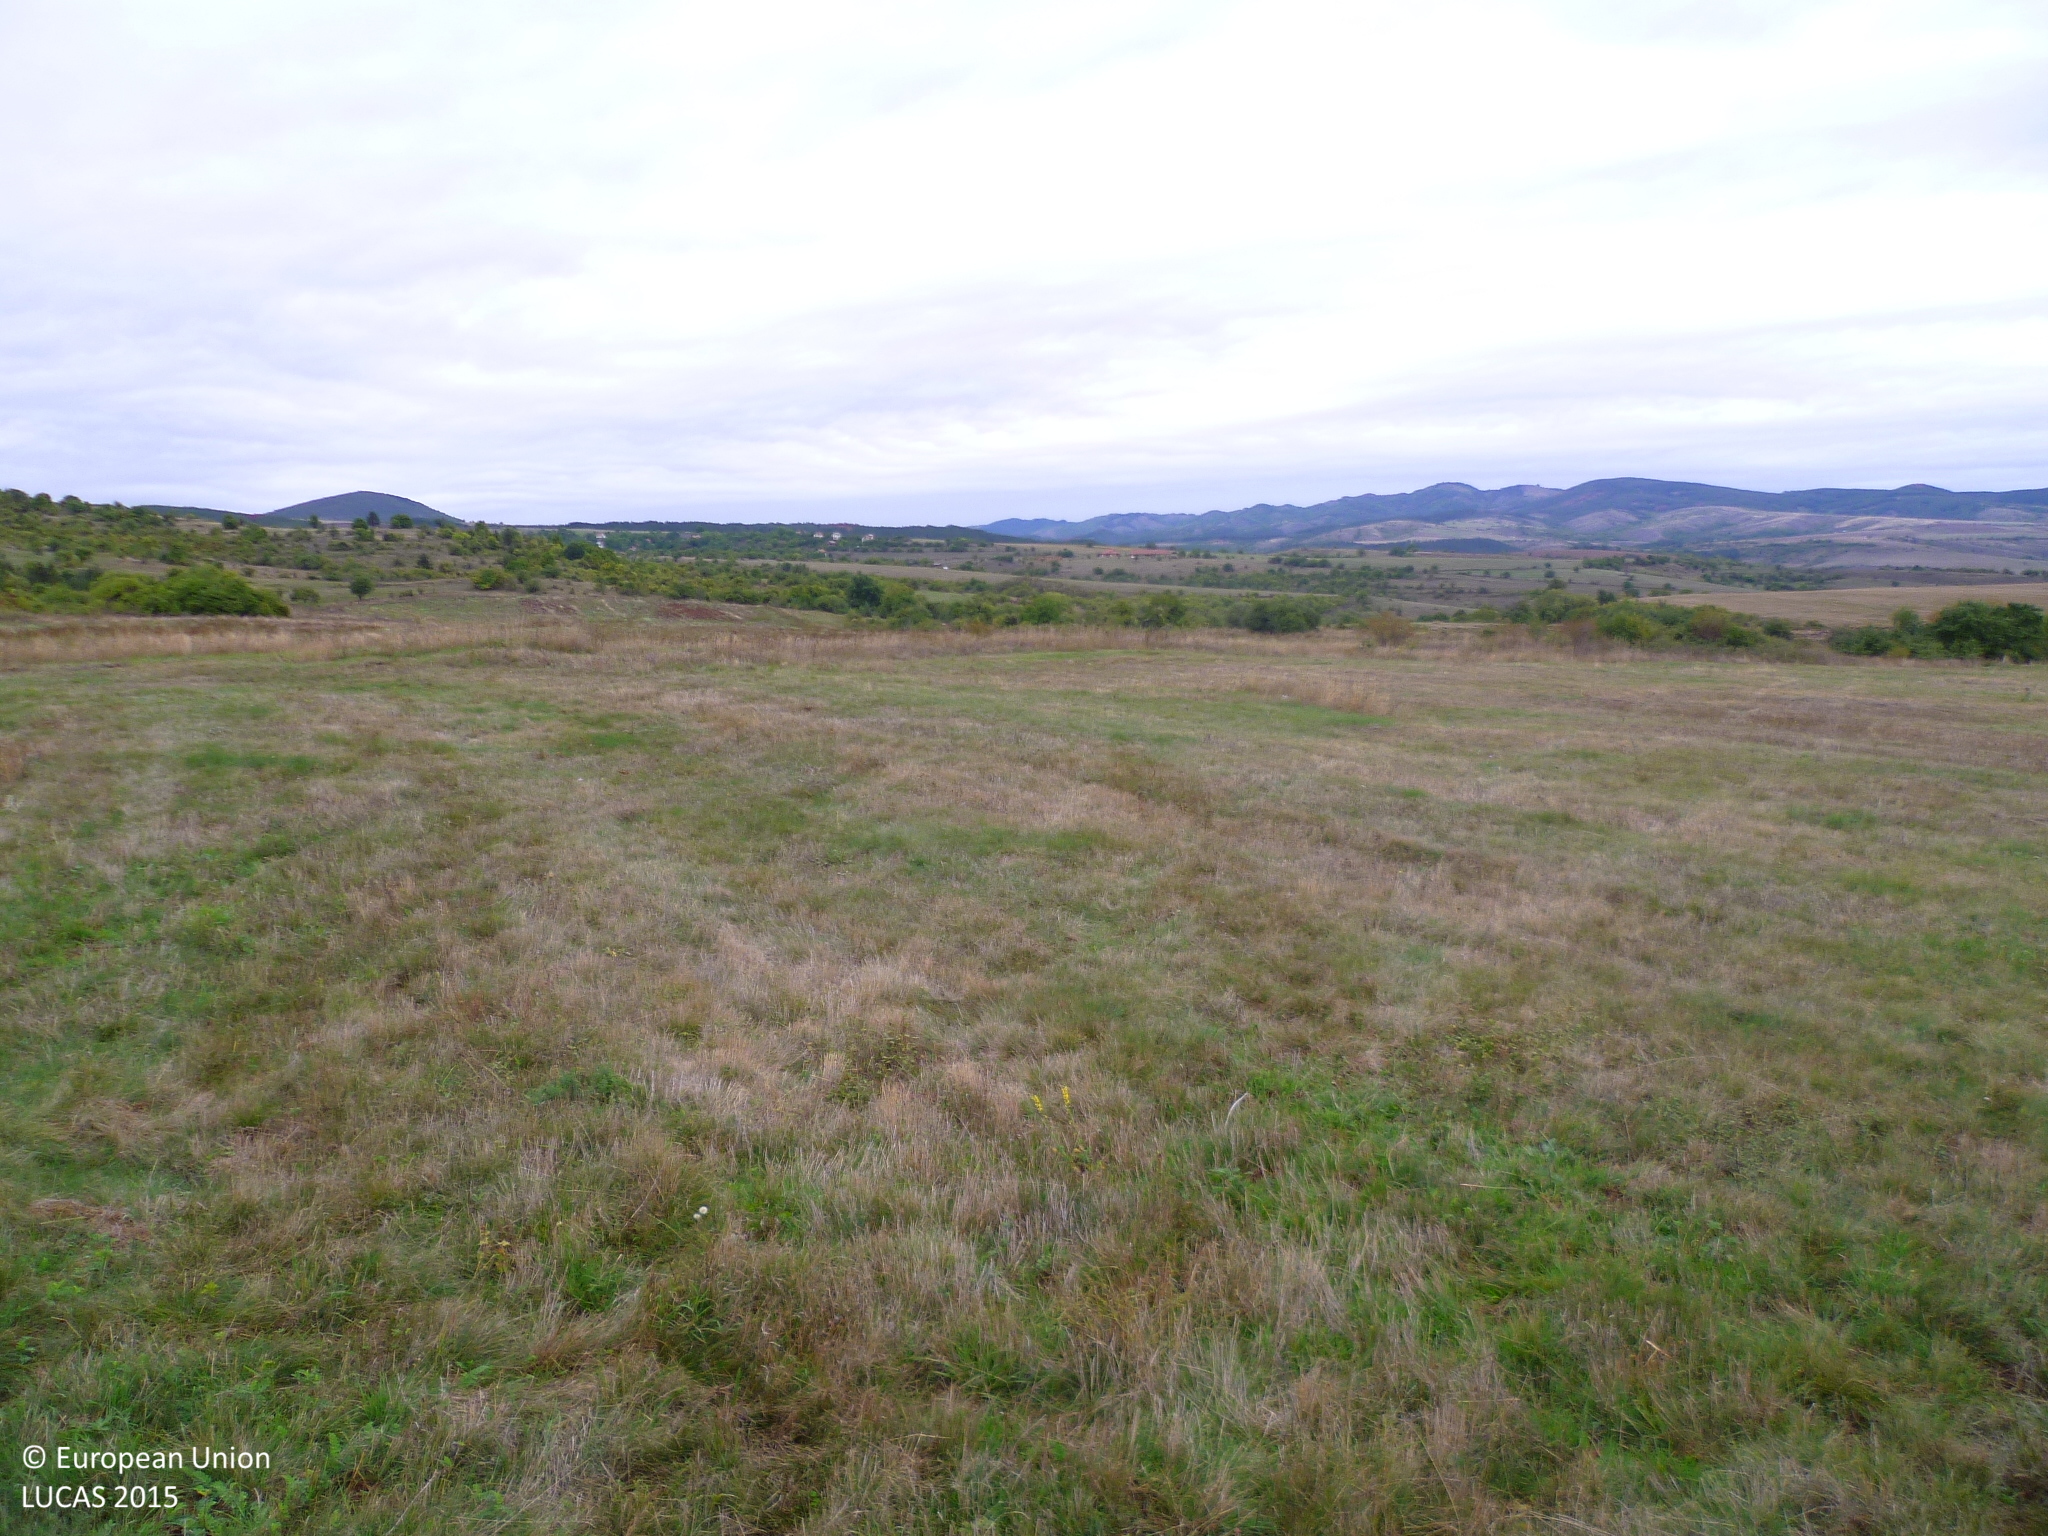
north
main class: Grassland
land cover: Grassland without tree/shrub cover
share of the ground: > 75 %
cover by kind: herbaceous plants 100 %
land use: Agriculture (excluding fallow land and kitchen gardens)
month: September
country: BG
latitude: 42.7549
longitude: 22.7709
